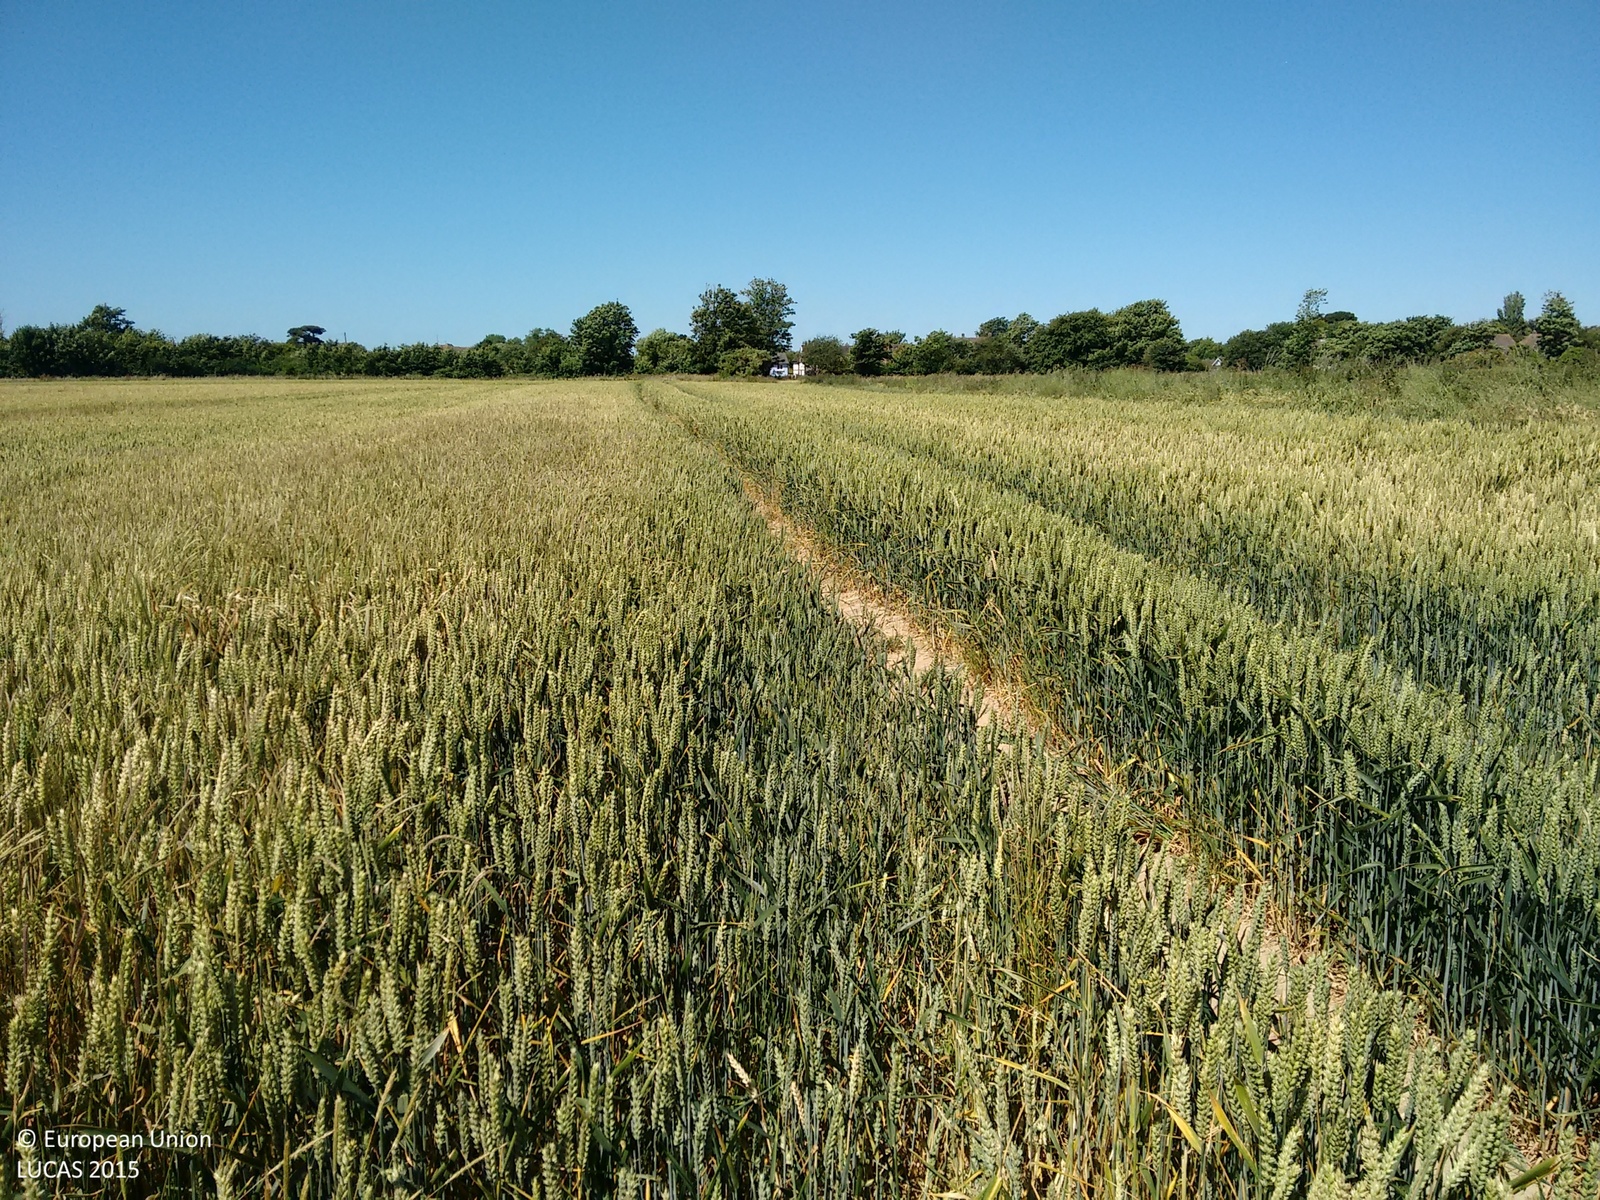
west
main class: Cropland
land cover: Common wheat
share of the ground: > 75 %
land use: Agriculture (excluding fallow land and kitchen gardens)
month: June
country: GB
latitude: 50.8098
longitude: -0.4400
